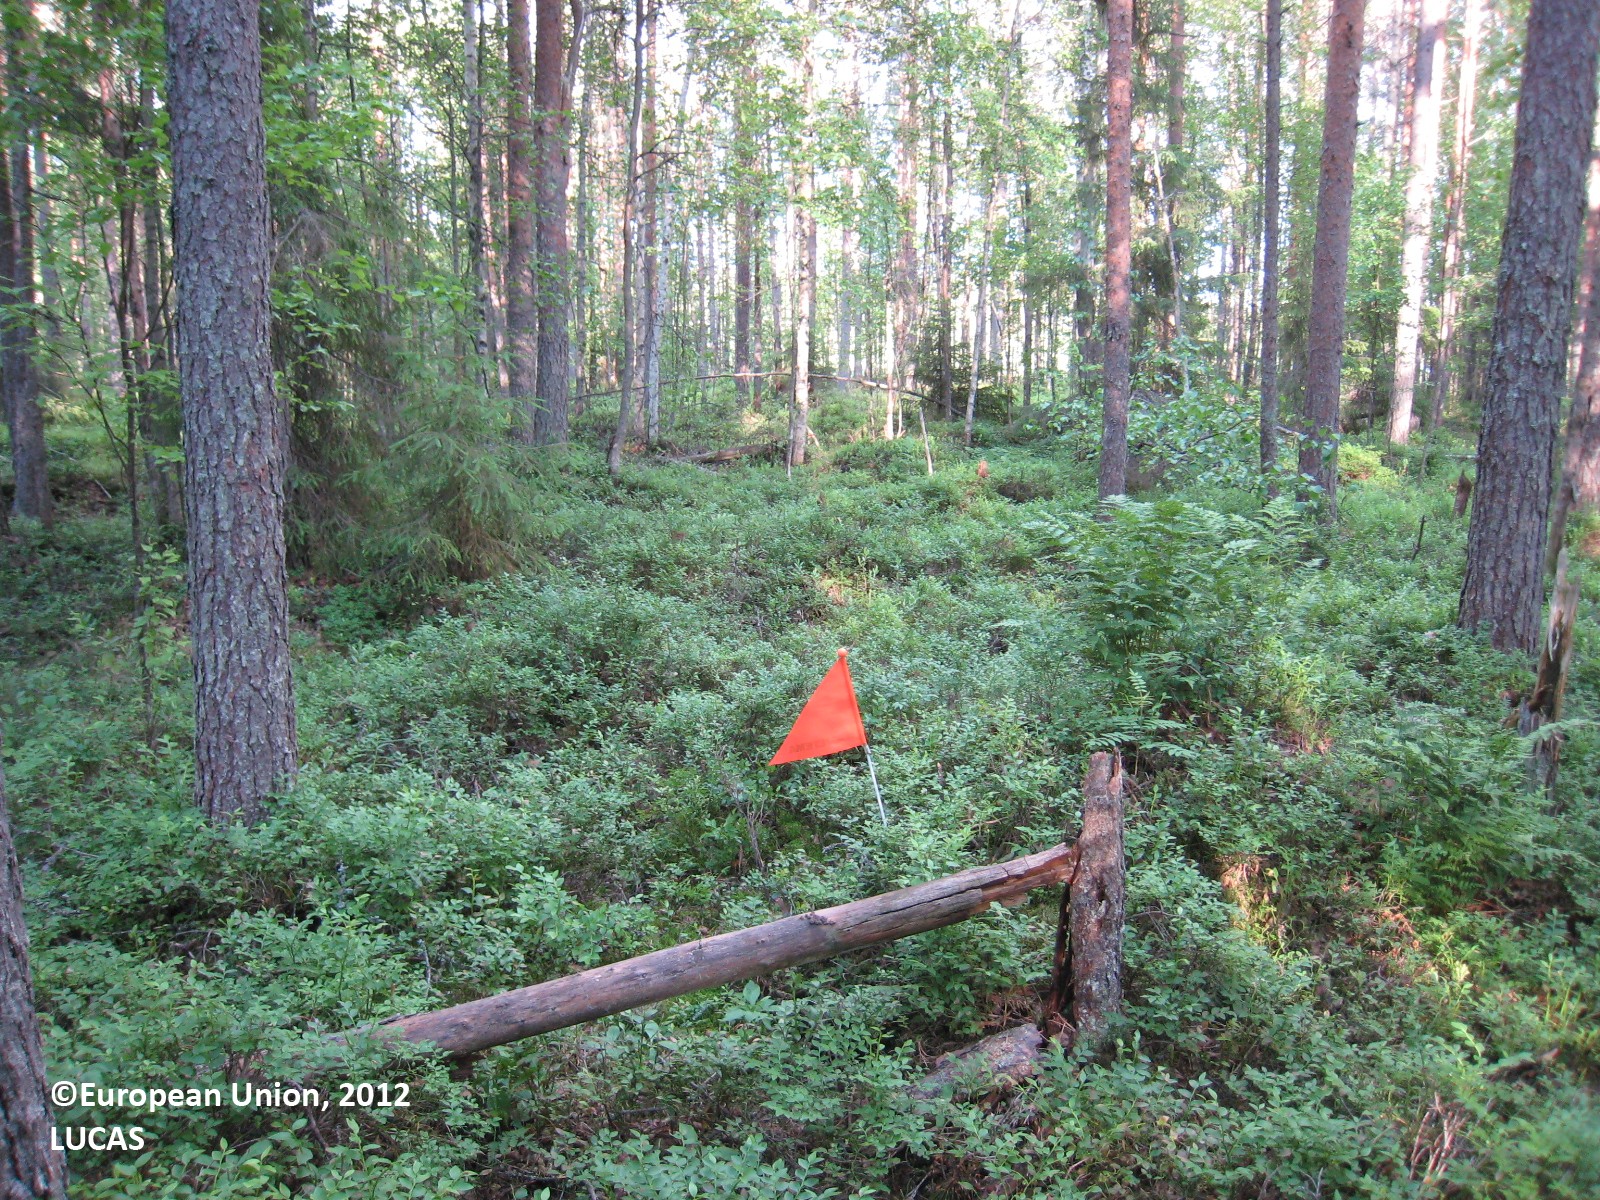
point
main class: Woodland
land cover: Pine dominated mixed woodland
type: boreal forest
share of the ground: 50 - 75 %
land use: Forestry
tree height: > 5 m
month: June
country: FI
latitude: 62.0120
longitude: 26.1199
